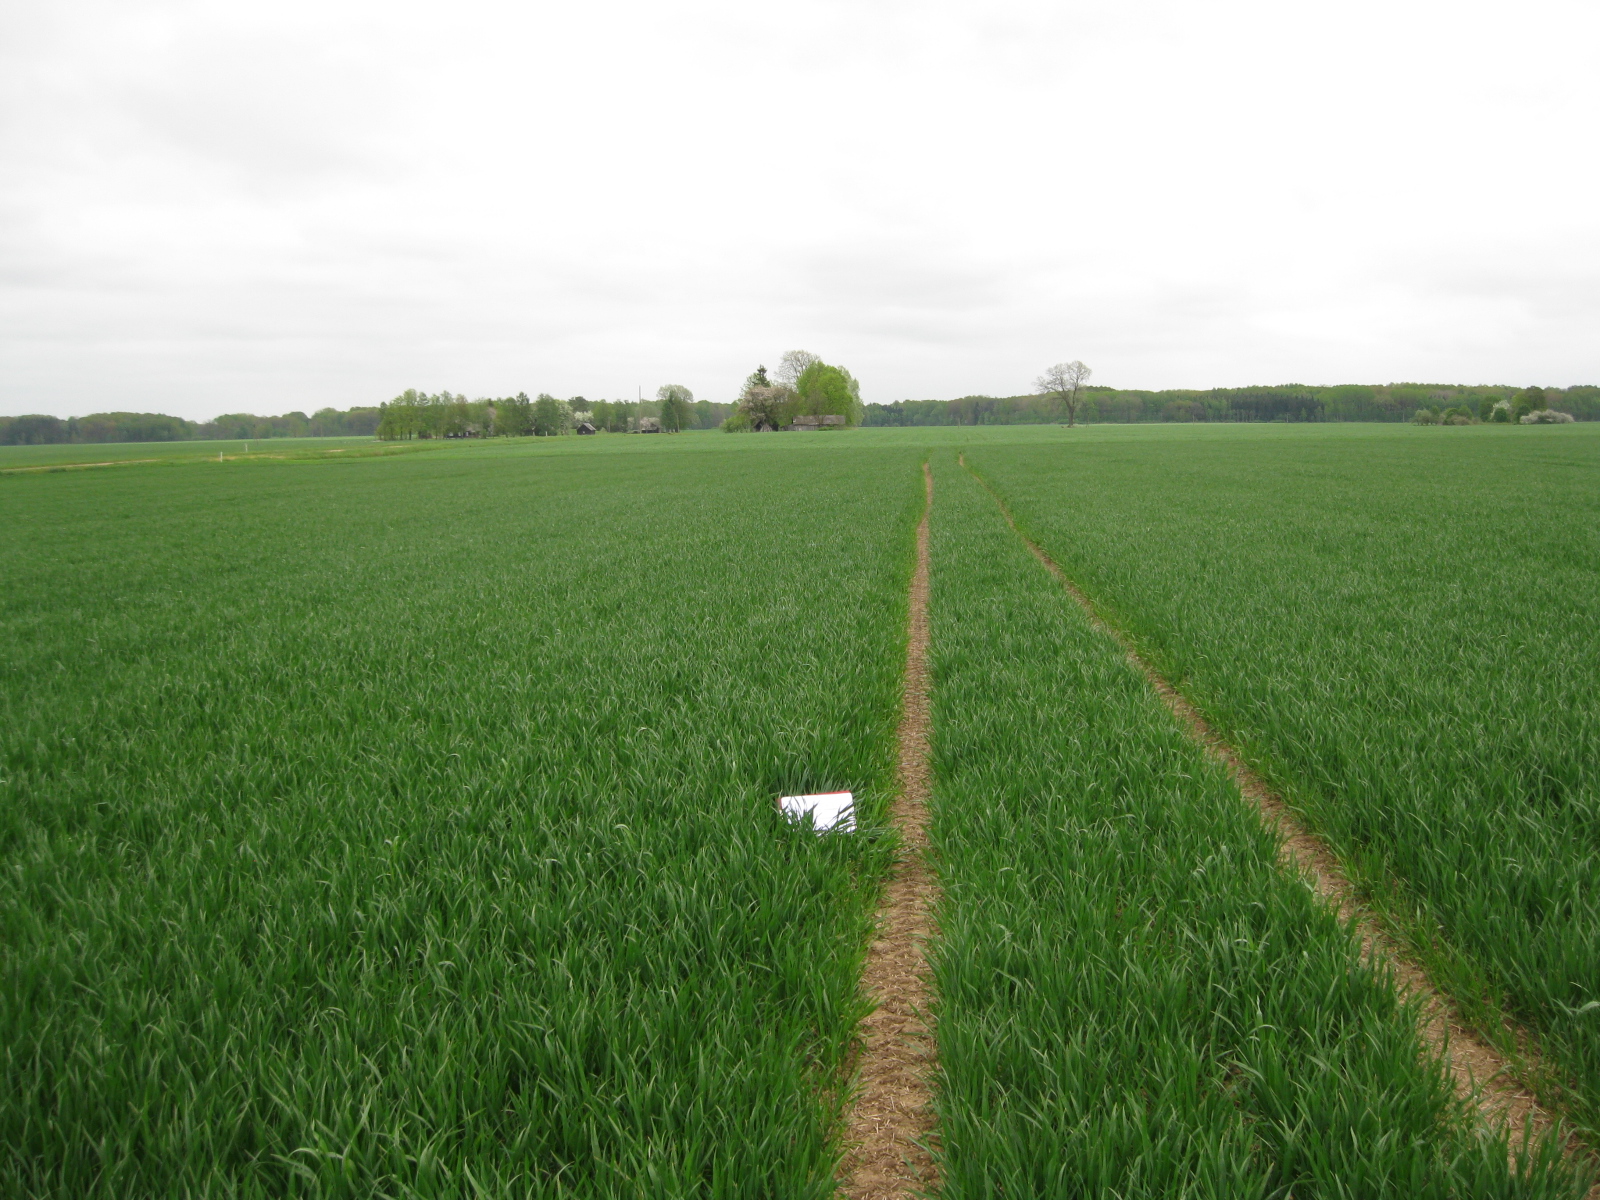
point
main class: Cropland
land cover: Common wheat
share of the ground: > 75 %
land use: Agriculture (excluding fallow land and kitchen gardens)
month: May
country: LT
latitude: 55.9939
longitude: 24.3802
